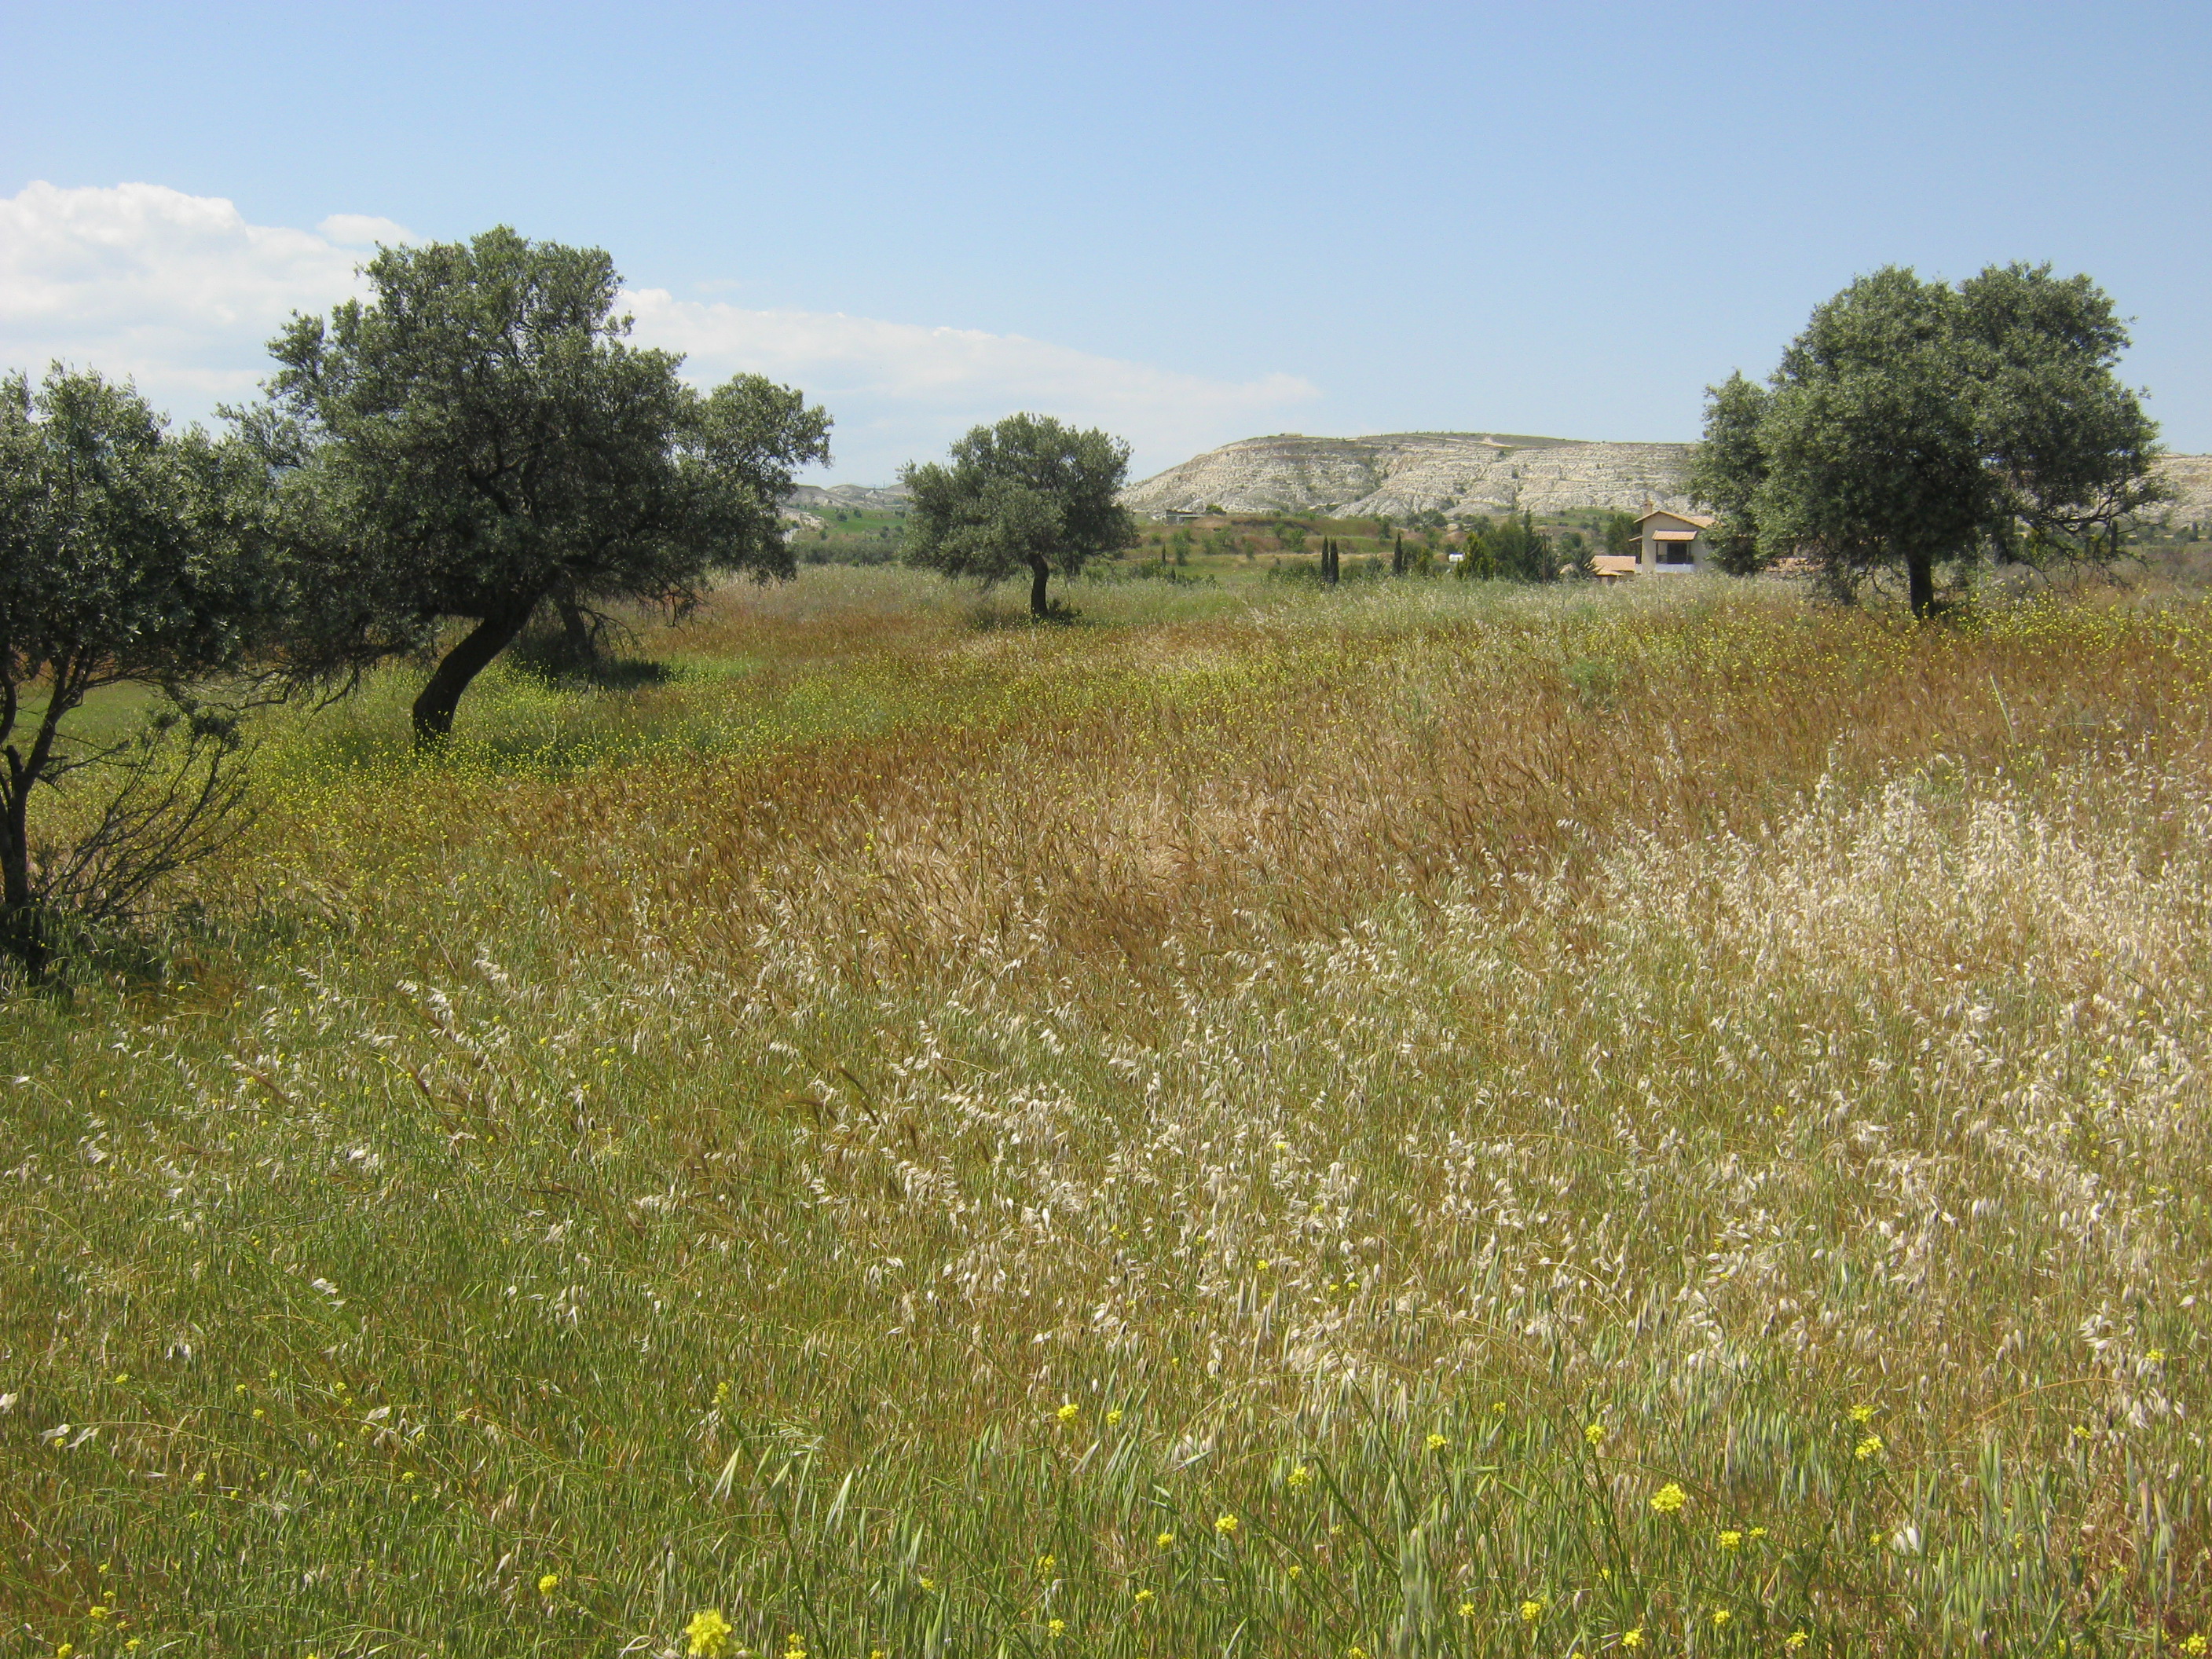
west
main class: Cropland
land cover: Olive groves
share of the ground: 10 - 25 %
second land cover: Grassland without tree/shrub cover
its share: > 75 %
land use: Agriculture (excluding fallow land and kitchen gardens)
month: April
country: CY
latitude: 35.0172
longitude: 33.2990
